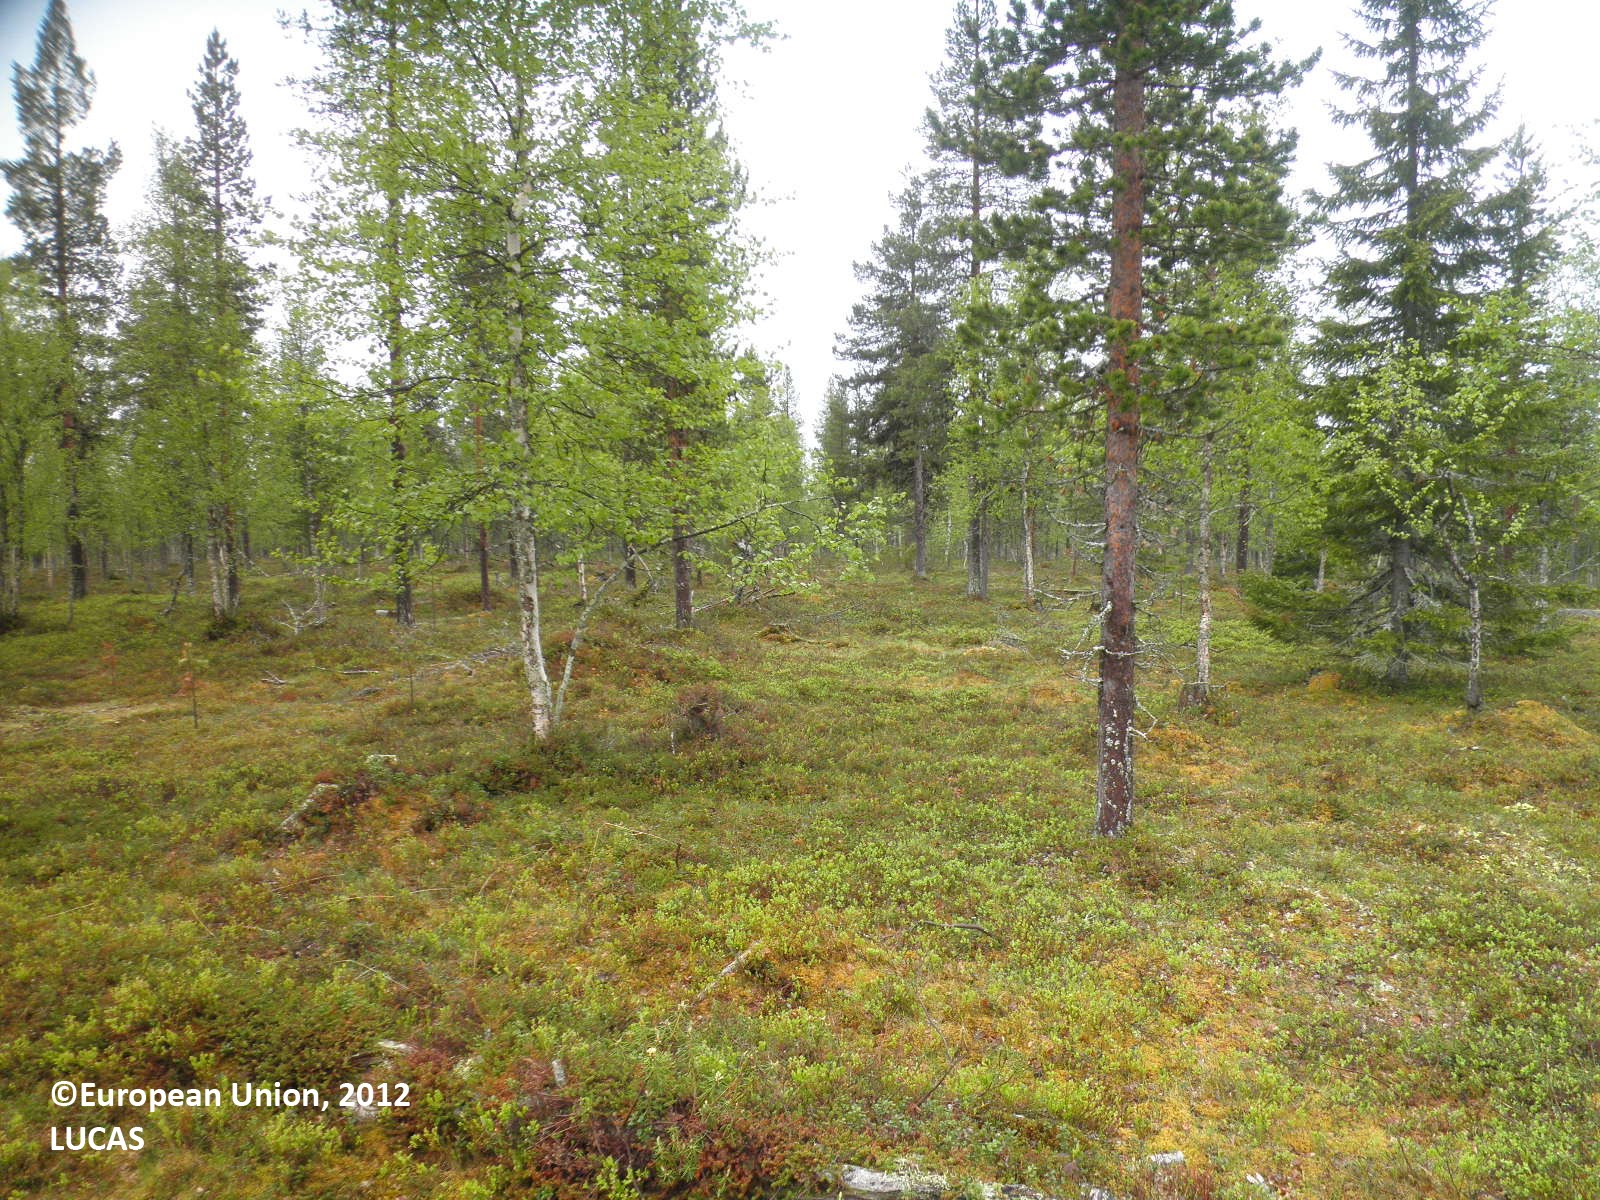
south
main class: Woodland
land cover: Pine dominated mixed woodland
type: boreal forest
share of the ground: 10 - 25 %
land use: Forestry
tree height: > 5 m
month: June
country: FI
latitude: 68.1110
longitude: 25.5435
